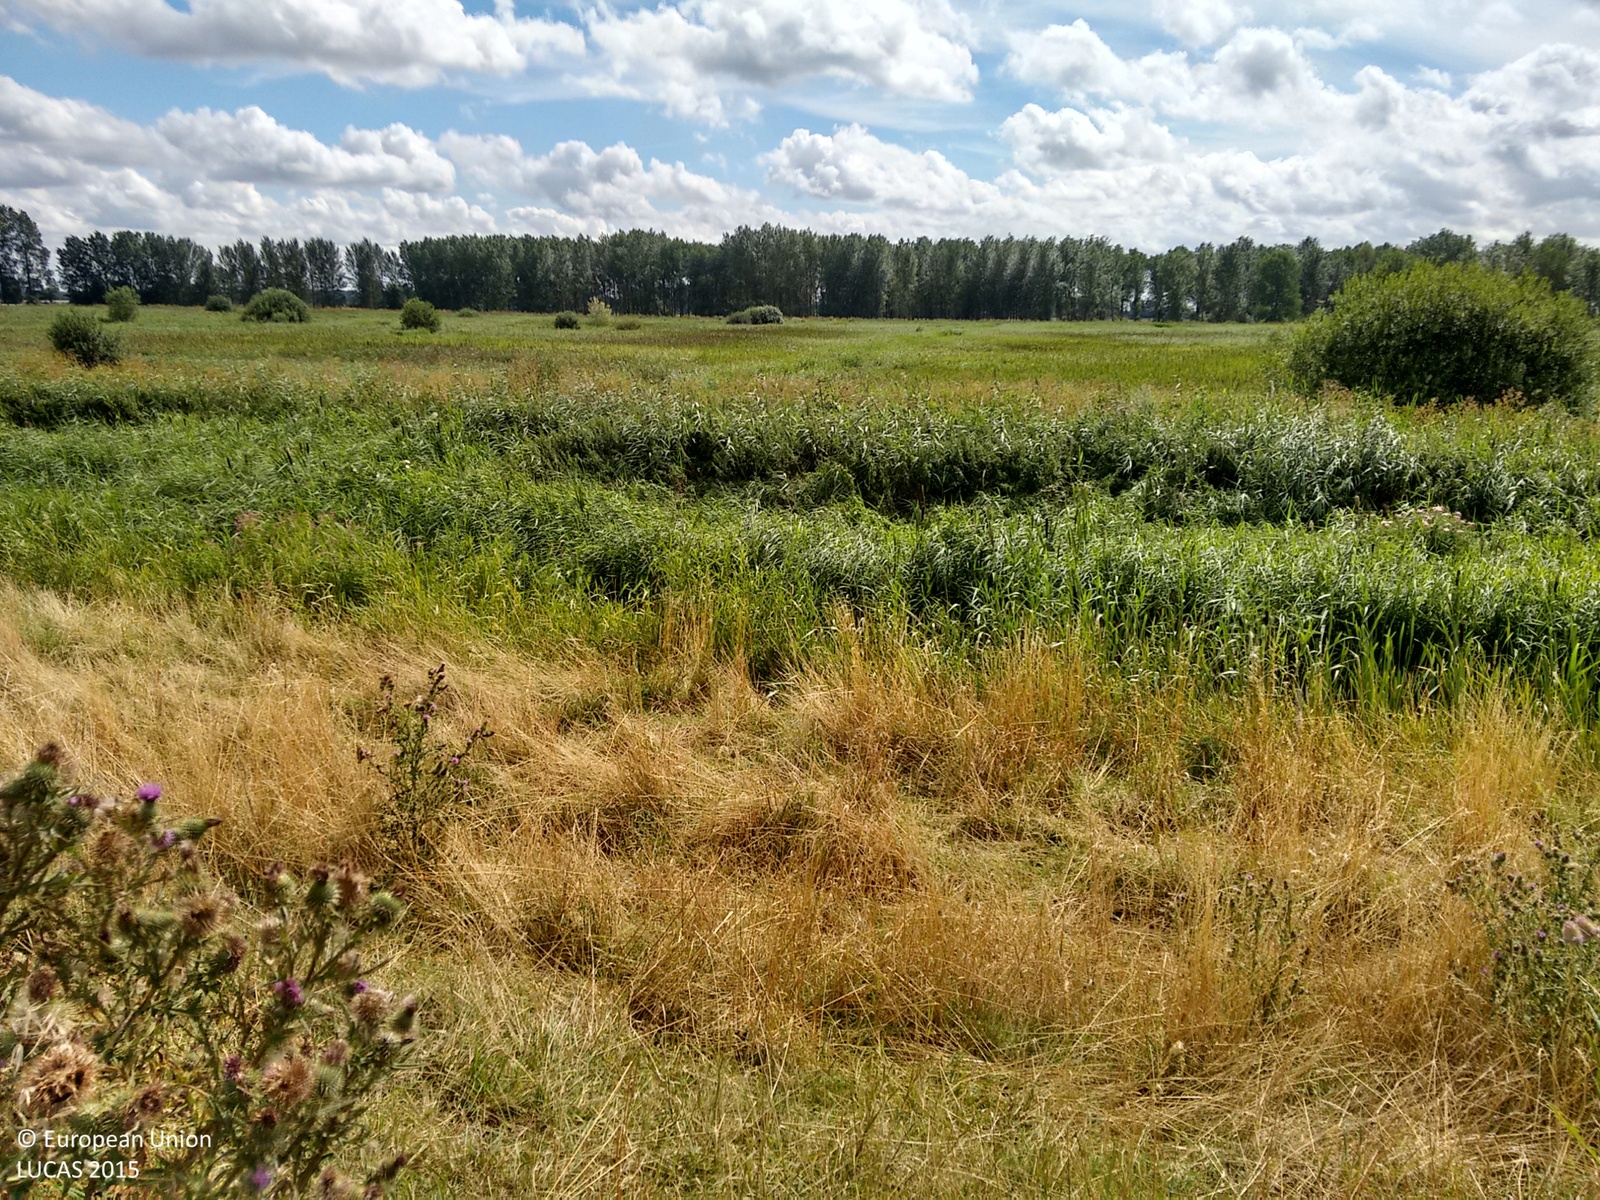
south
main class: Grassland
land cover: Grassland with sparse tree/shrub cover
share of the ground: > 75 %
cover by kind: herbaceous plants 95 %, broadleaved forest trees 5 %
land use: Agriculture (excluding fallow land and kitchen gardens)
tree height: < 5 m
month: August
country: GB
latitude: 52.4493
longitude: 0.5116
